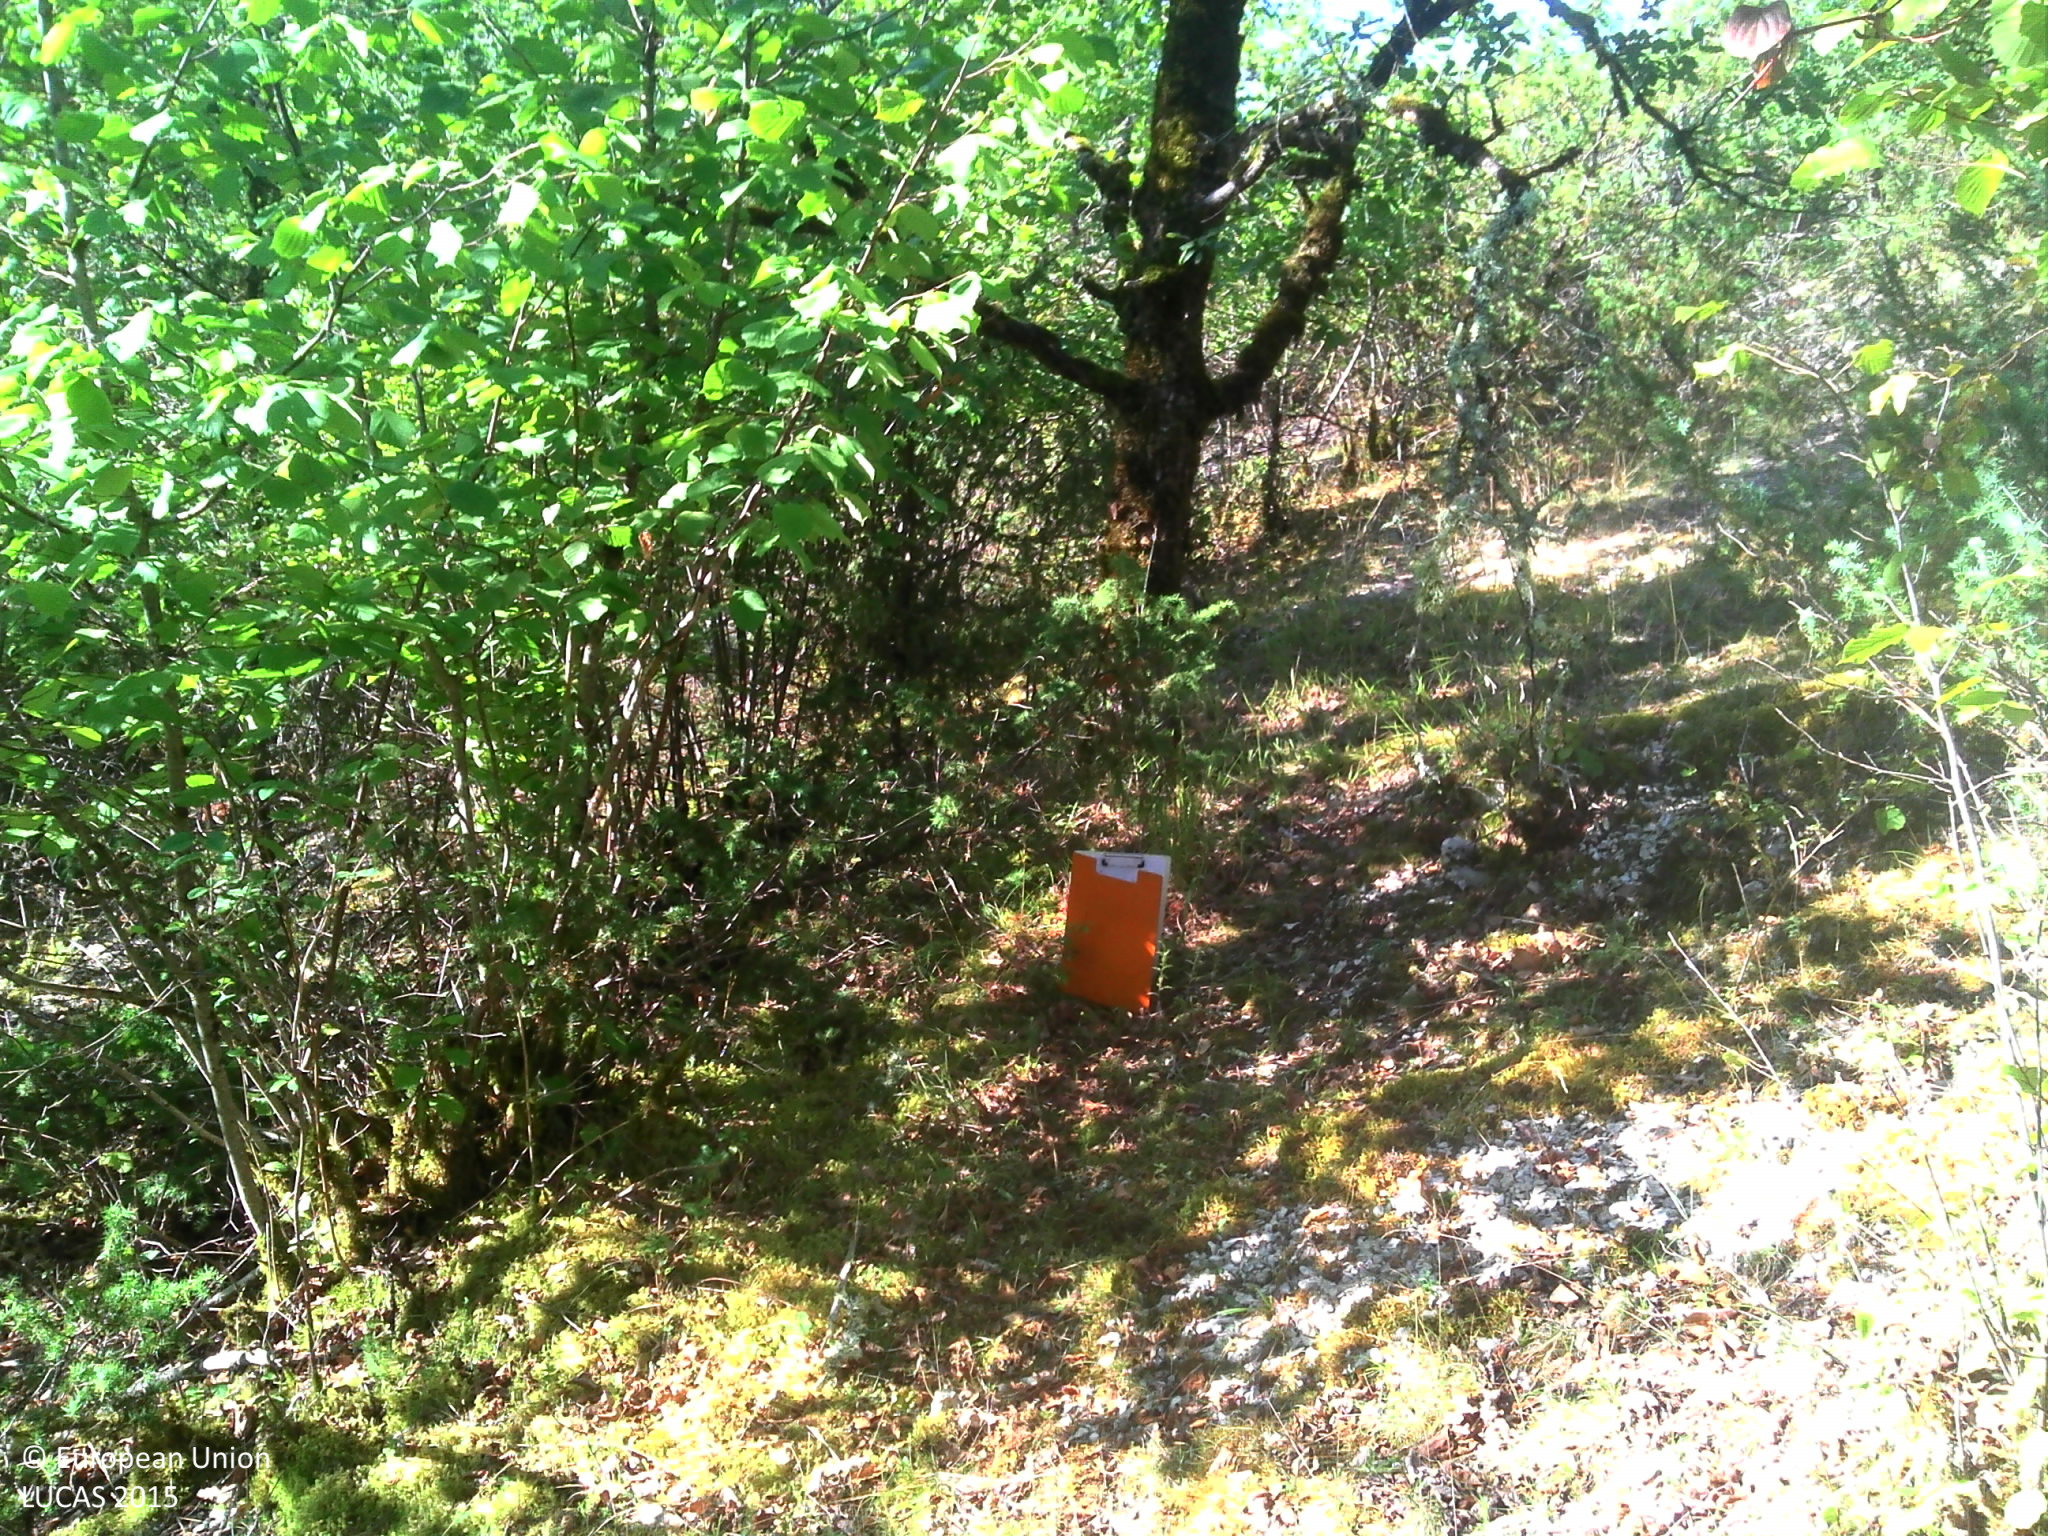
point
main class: Shrubland
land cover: Shrubland with sparse tree cover
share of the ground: > 75 %
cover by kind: shrubs 45 %, unconsolidated bare surface 30 %, herbaceous plants 20 %, broadleaved forest trees 5 %
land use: Forestry
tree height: > 5 m
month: August
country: FR
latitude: 44.7723
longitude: 1.6199
